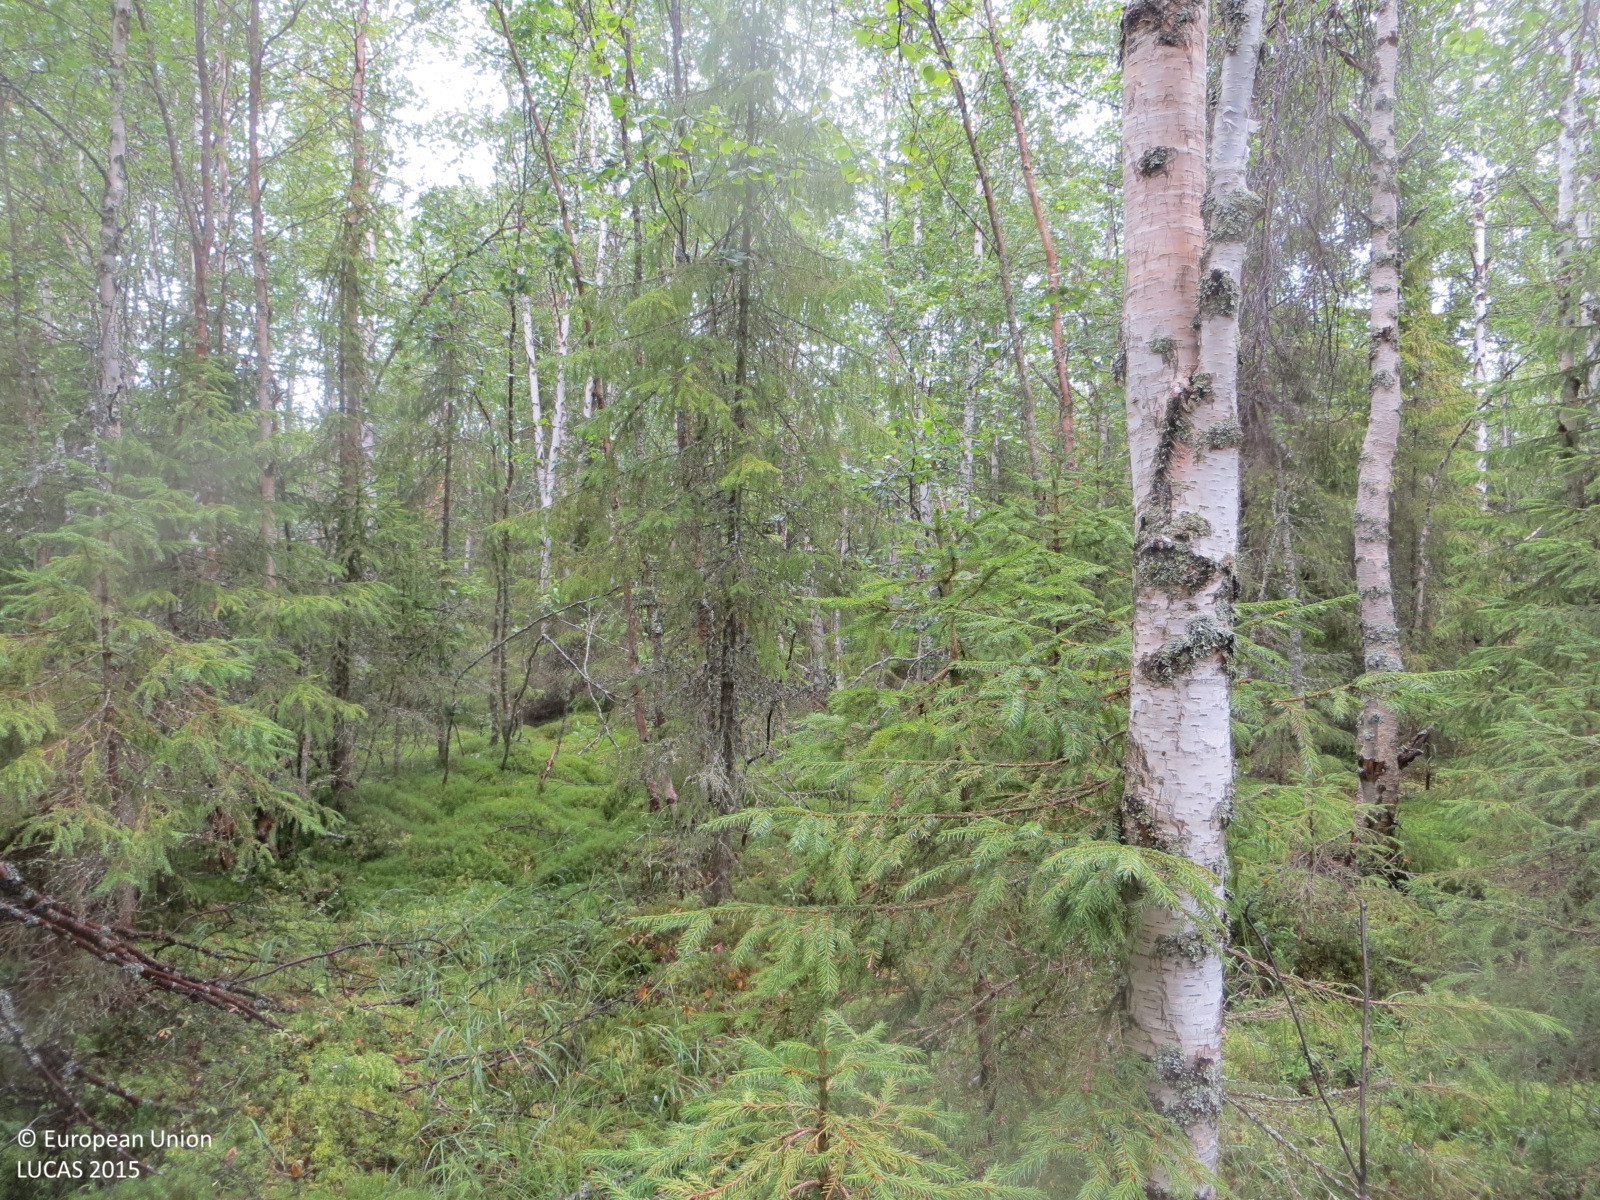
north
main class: Woodland
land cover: Spruce dominated mixed woodland
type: boreal forest
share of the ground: 50 - 75 %
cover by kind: broadleaved forest trees 40 %, coniferous forest trees 30 %, lichens and mosses 30 %
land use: Forestry
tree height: > 5 m
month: July
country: FI
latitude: 65.9832
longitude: 24.6526
